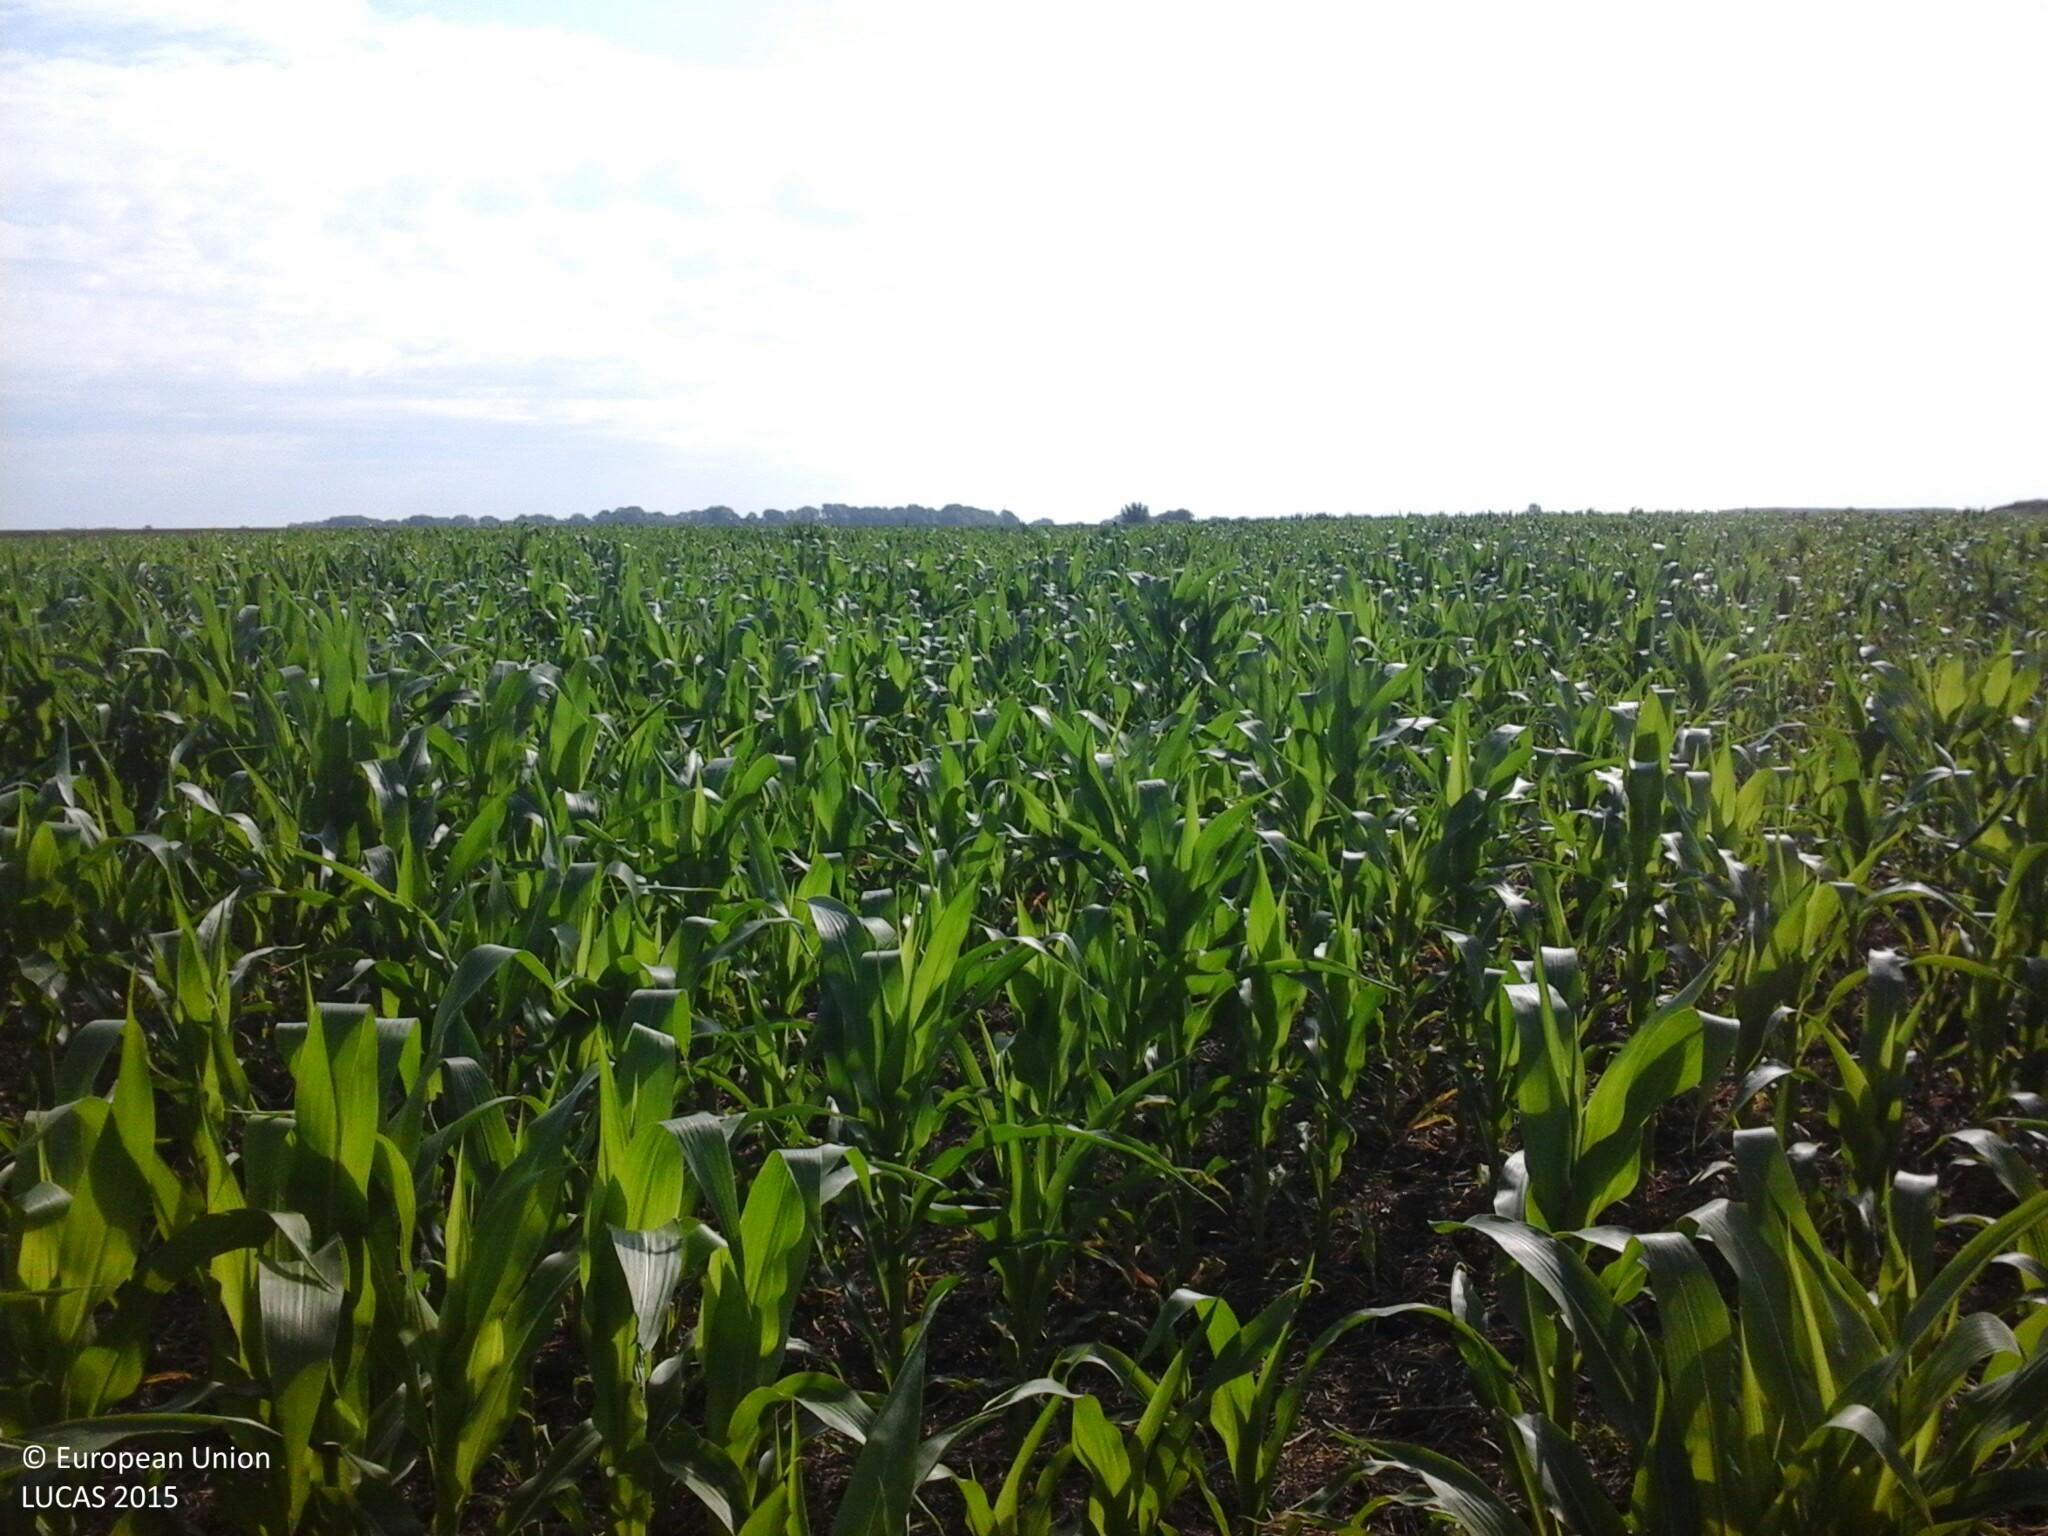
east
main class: Cropland
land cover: Maize
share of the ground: 50 - 75 %
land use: Agriculture (excluding fallow land and kitchen gardens)
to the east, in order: Maize; Grass margins; Ditches and canals; Spontaneously vegetated surfaces
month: July
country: HU
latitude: 48.0142
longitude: 22.3781
